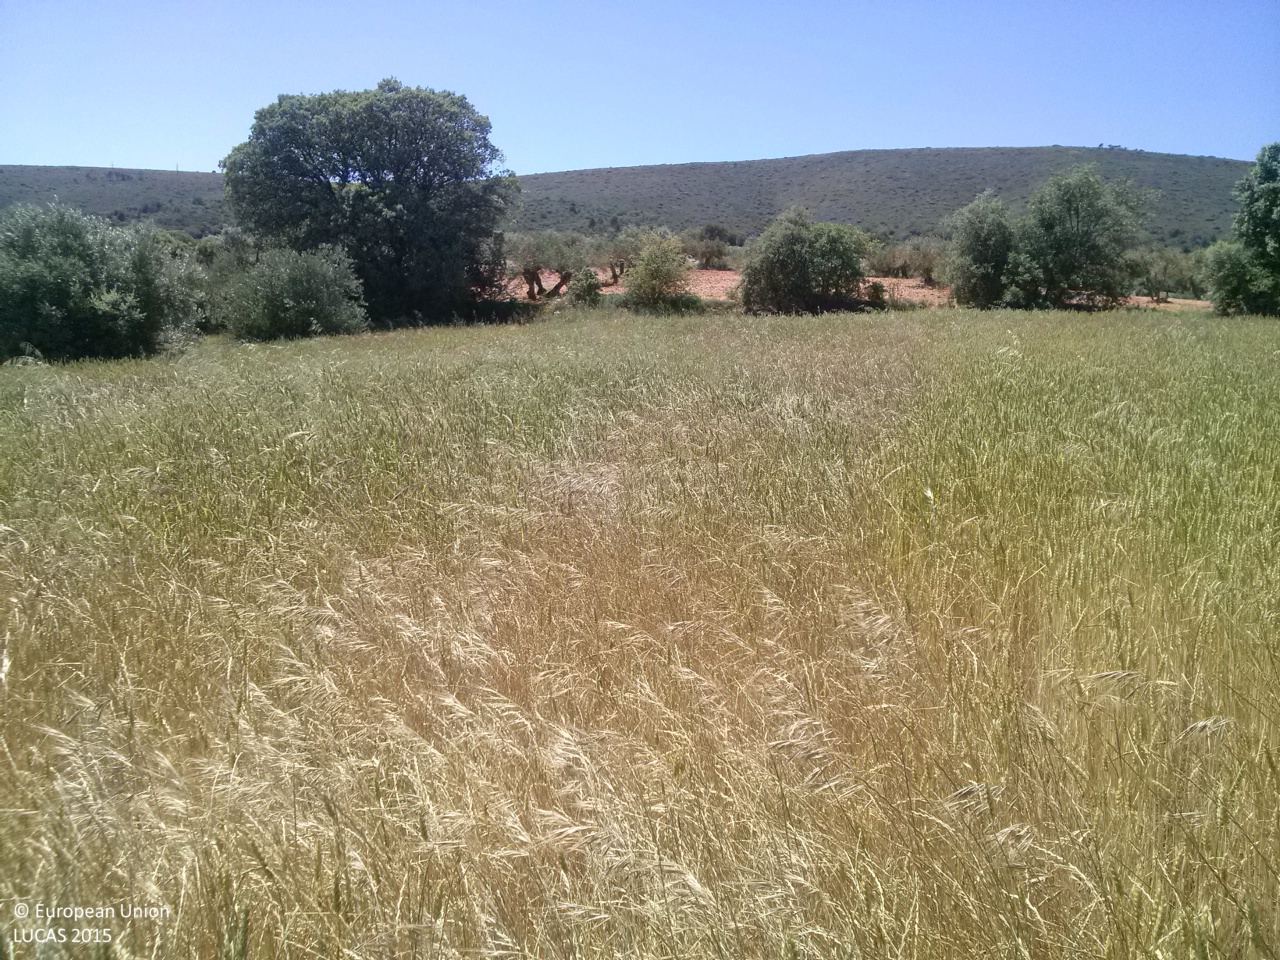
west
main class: Cropland
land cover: Common wheat
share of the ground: > 75 %
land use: Agriculture (excluding fallow land and kitchen gardens)
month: May
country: ES
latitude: 40.3430
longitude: -2.7749
